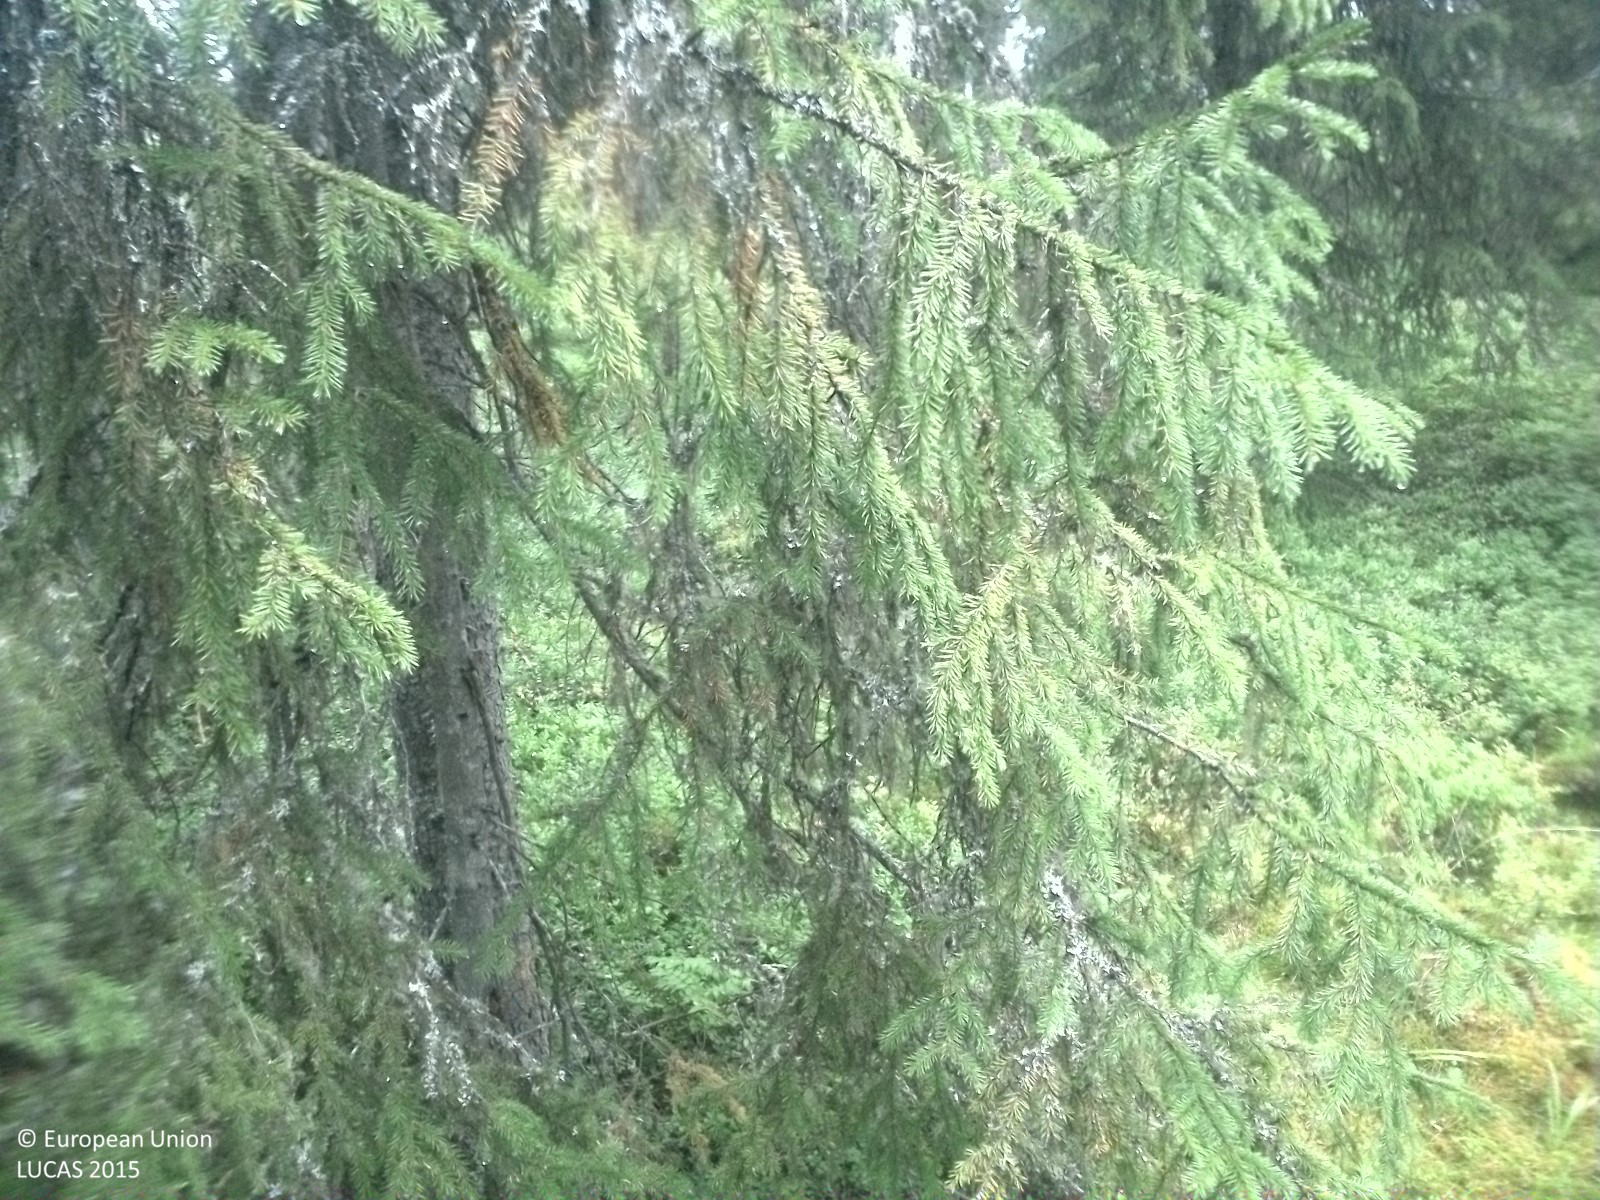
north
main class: Woodland
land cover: Spruce dominated coniferous woodland
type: boreal forest
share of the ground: 50 - 75 %
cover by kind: coniferous forest trees 55 %, shrubs 40 %, broadleaved forest trees 5 %
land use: Forestry
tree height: > 5 m
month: August
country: SE
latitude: 62.2643
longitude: 16.2786
